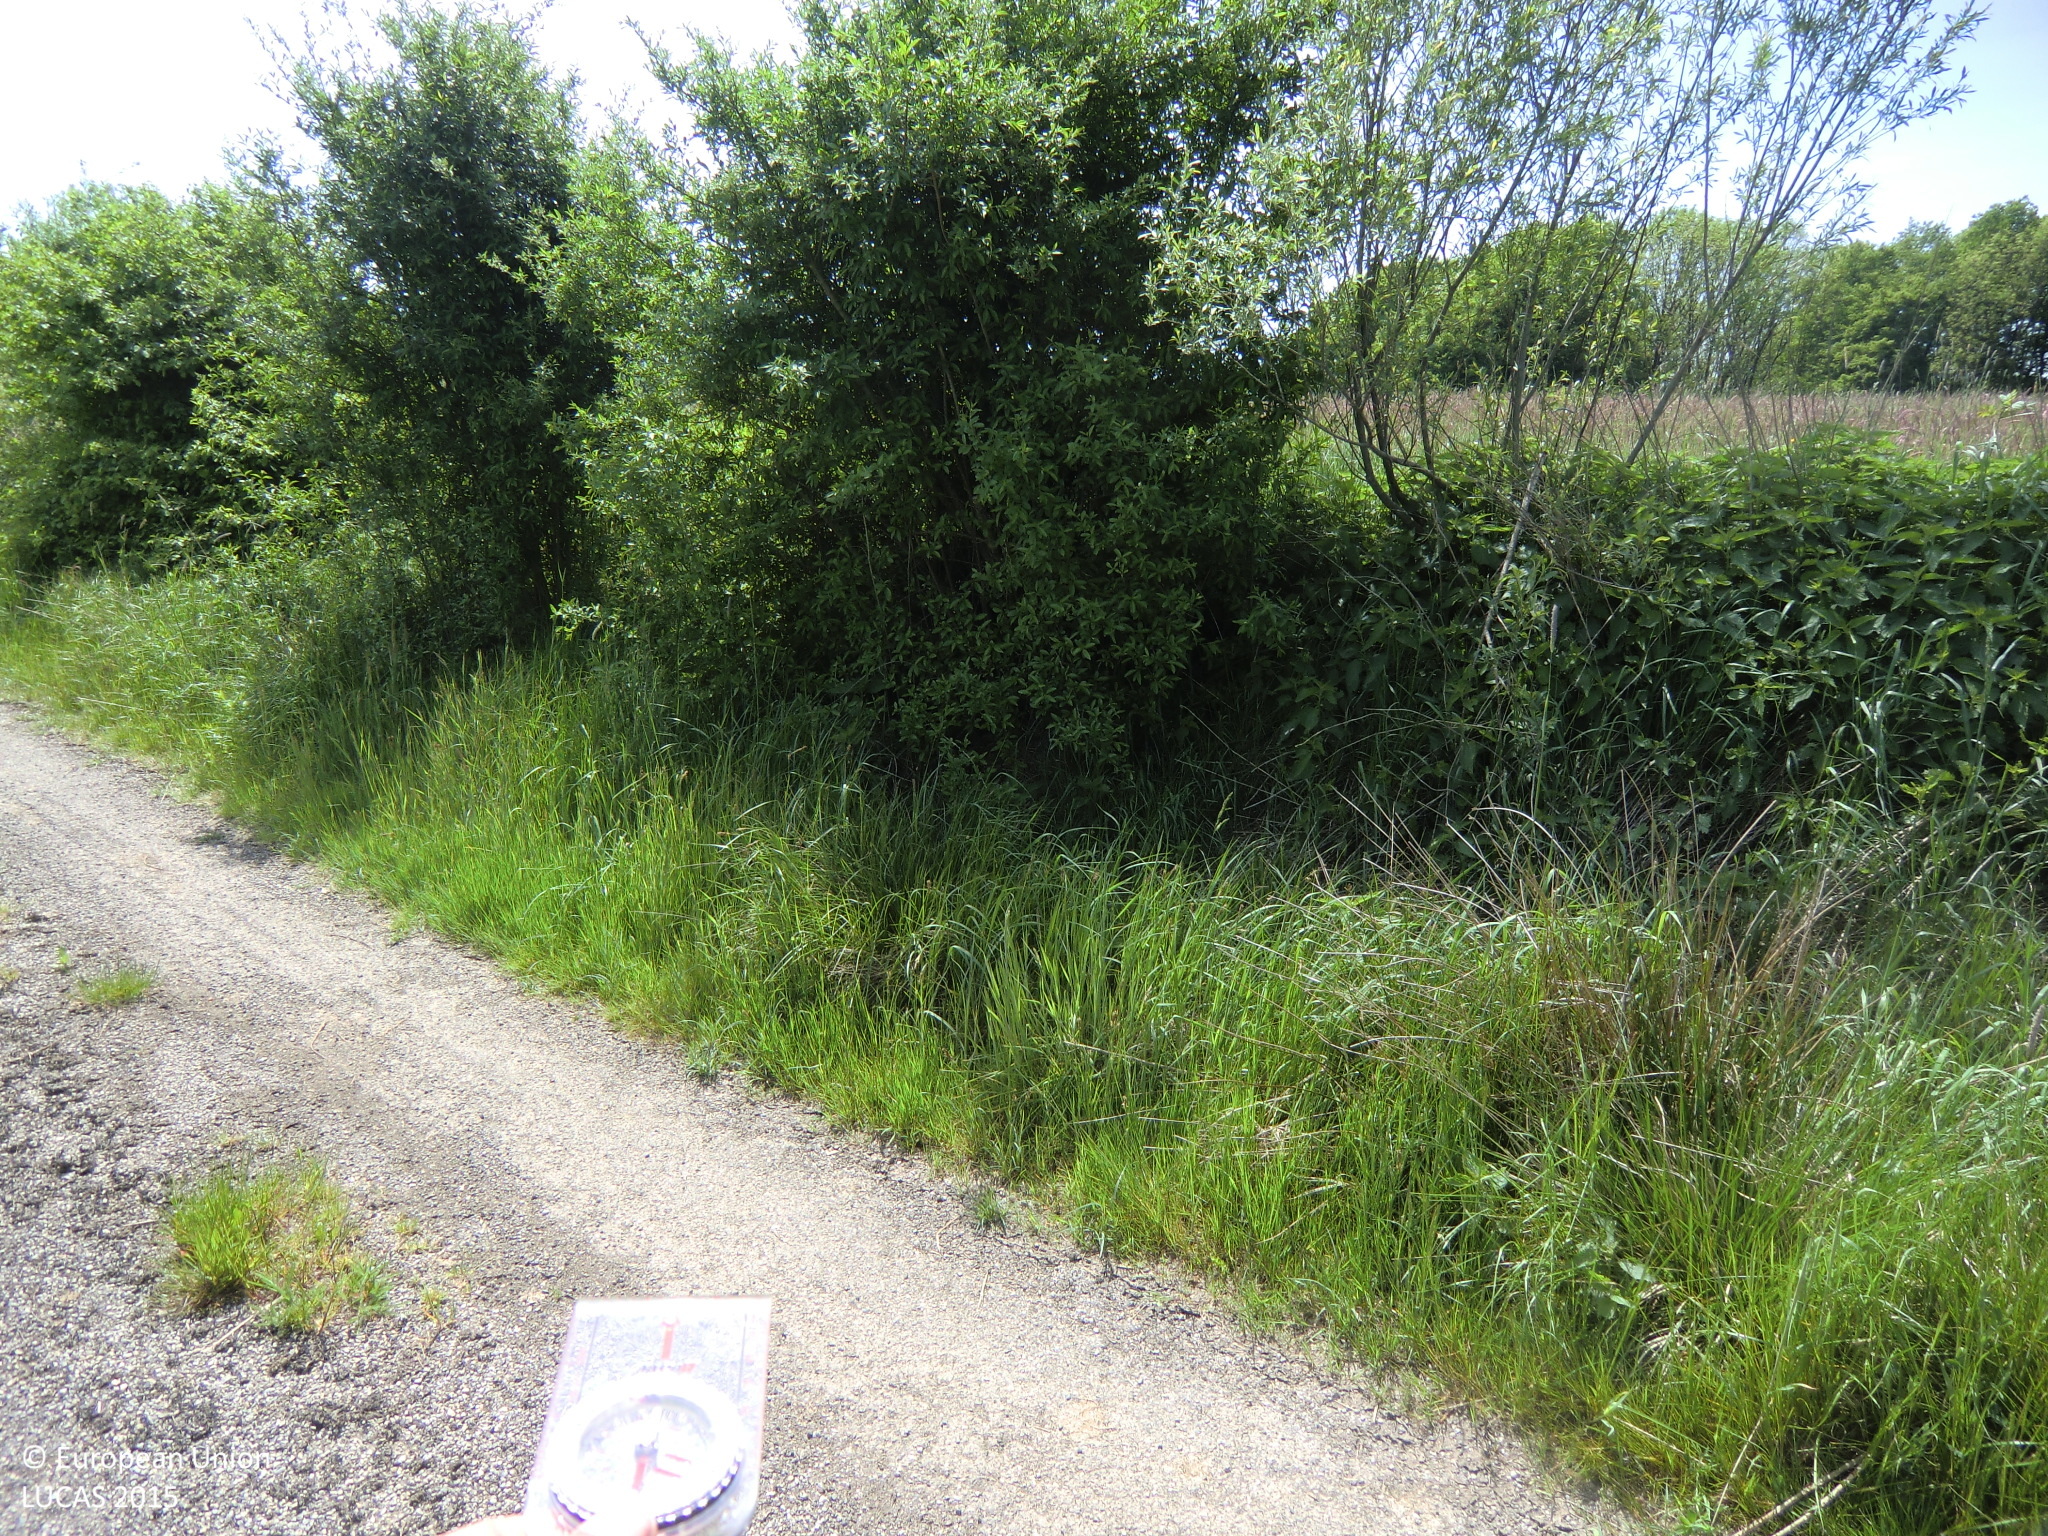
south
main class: Grassland
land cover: Grassland without tree/shrub cover
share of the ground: > 75 %
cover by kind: herbaceous plants 100 %
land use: Agriculture (excluding fallow land and kitchen gardens)
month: May
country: AT
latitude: 48.1663
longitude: 15.3398
